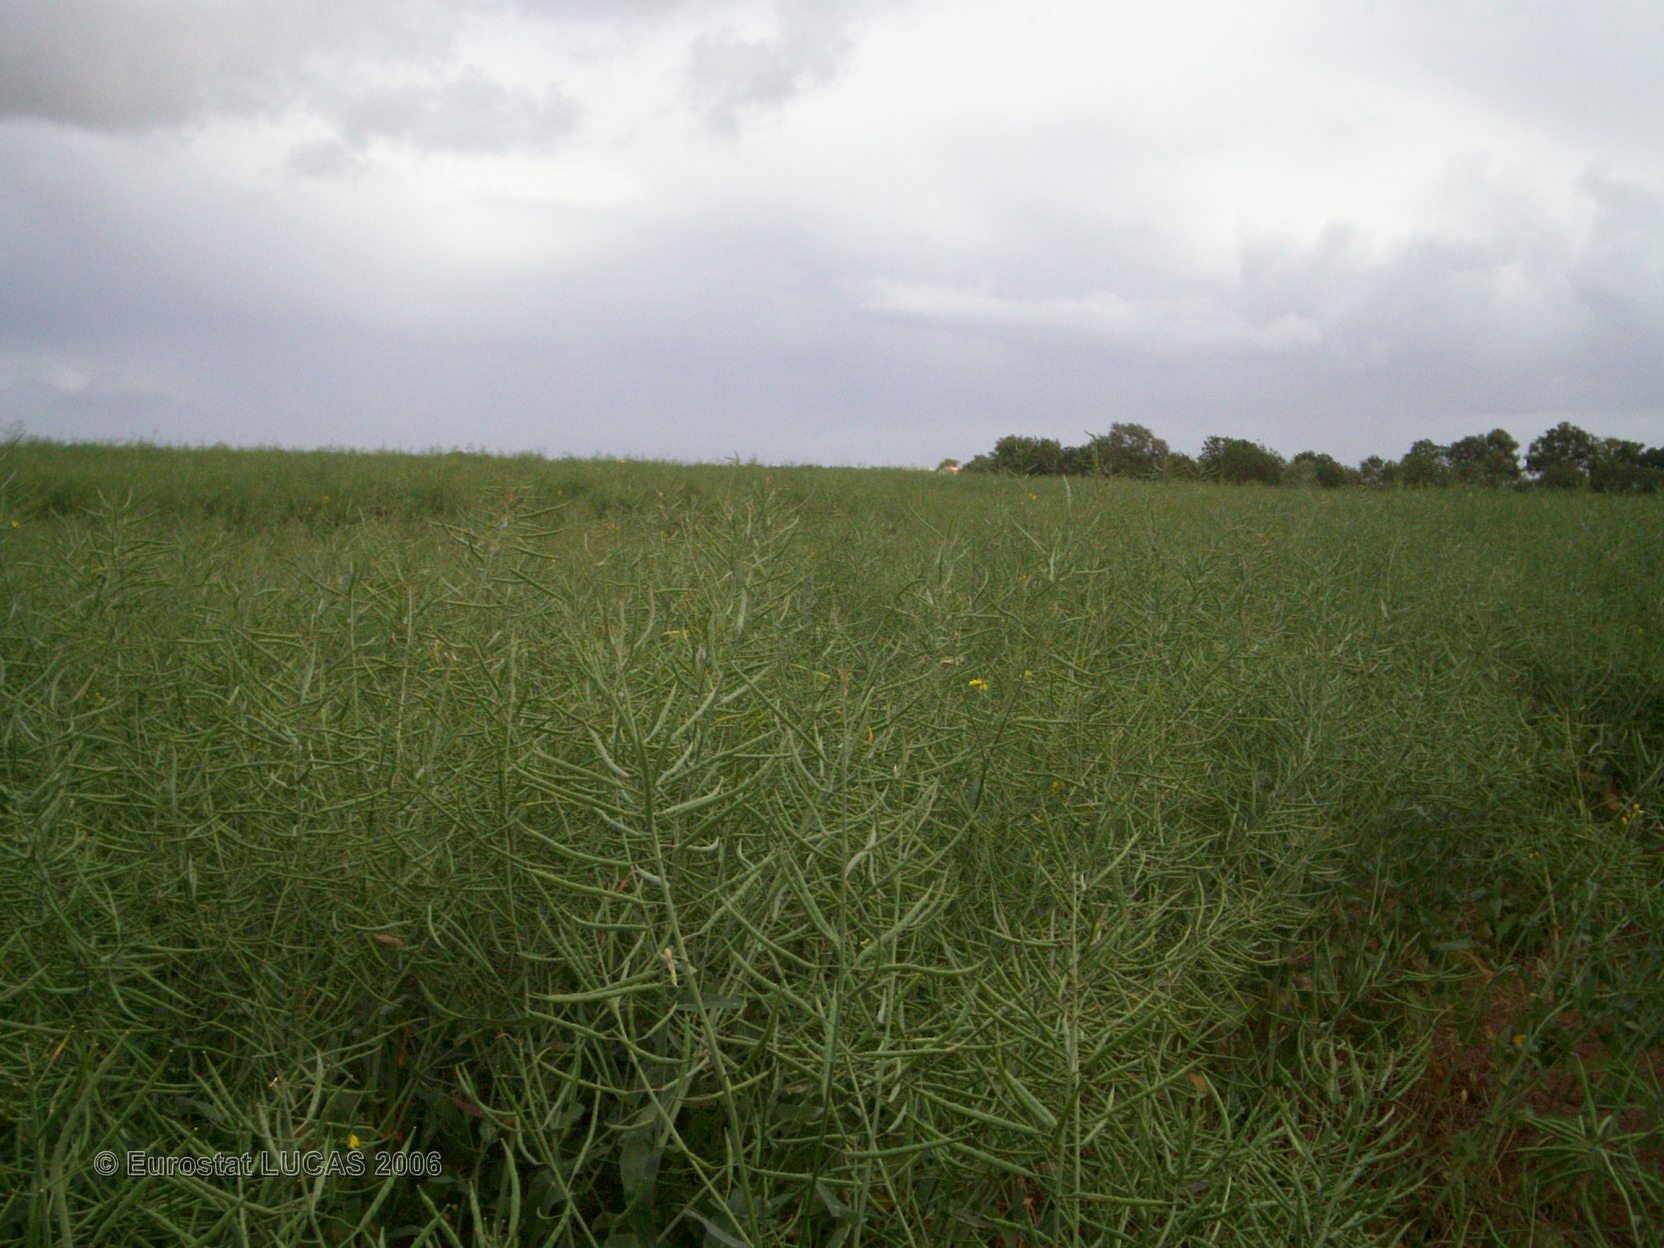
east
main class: Cropland
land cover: Rape and turnip rape
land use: Agriculture (excluding fallow land and kitchen gardens)
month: May
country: FR
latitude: 46.4187
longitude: -0.8155
